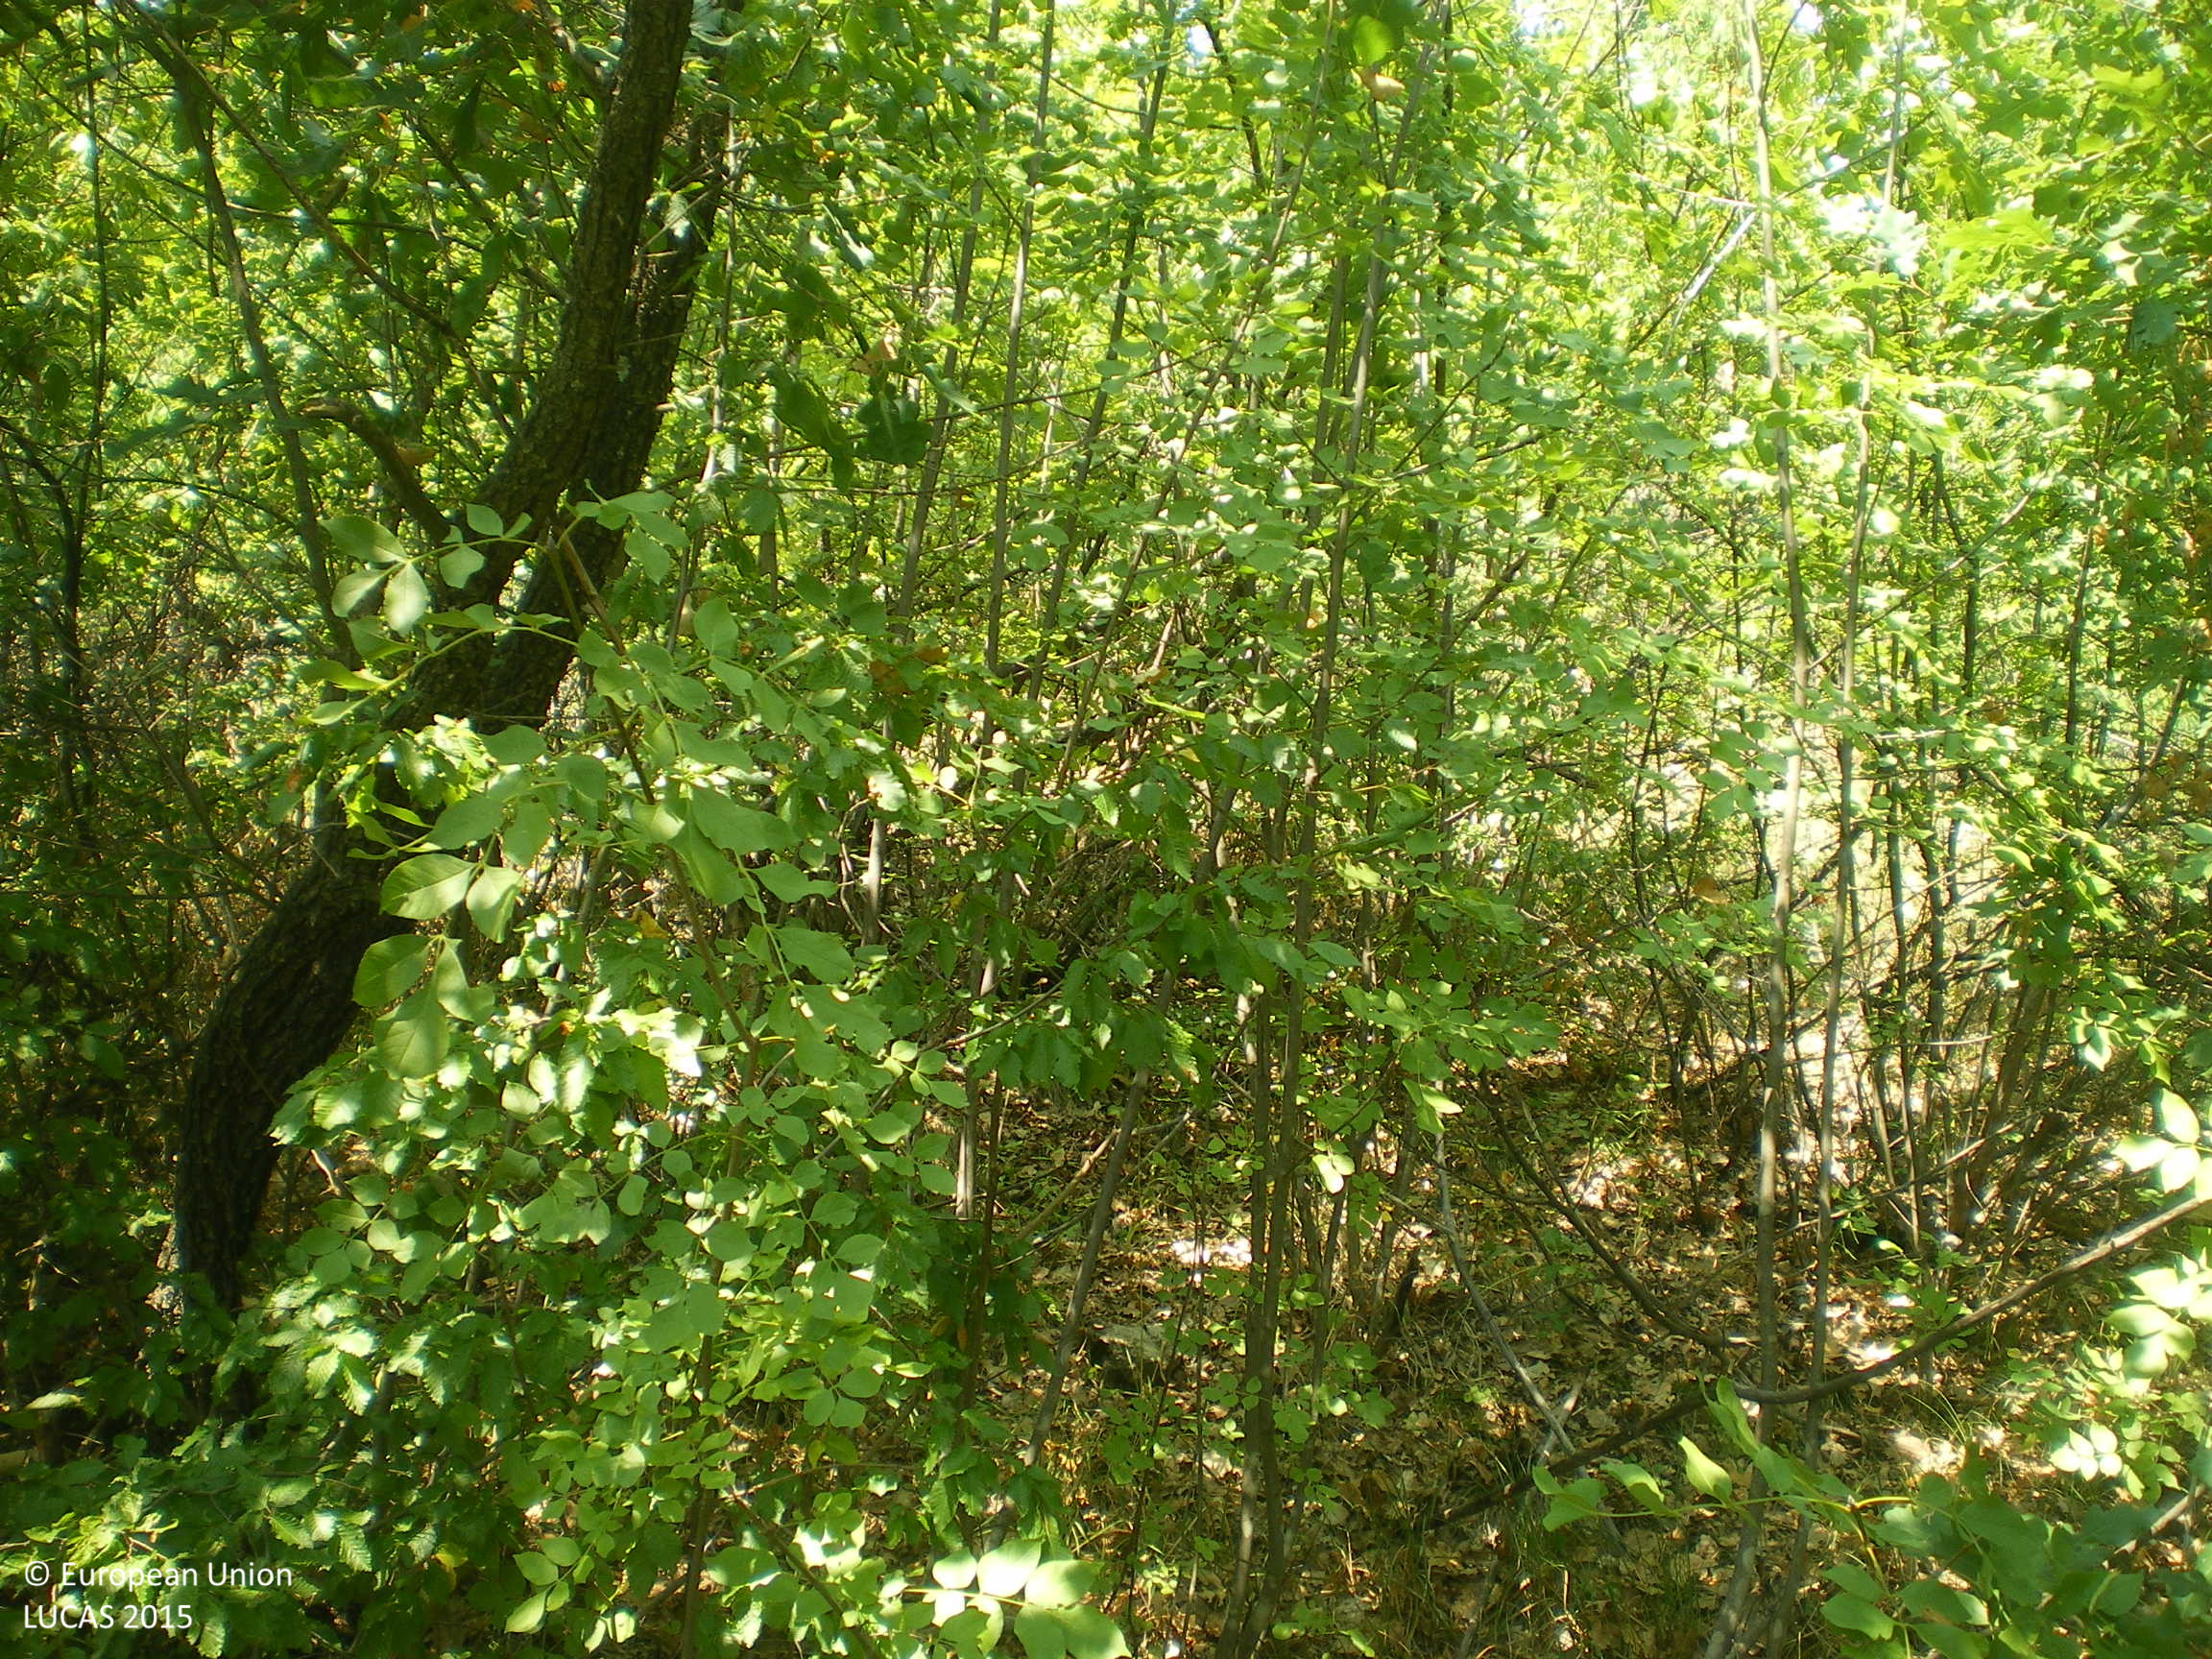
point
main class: Woodland
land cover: Broadleaved woodland
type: mesophytic deciduous forest
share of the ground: > 75 %
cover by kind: broadleaved forest trees 95 %, unconsolidated bare surface 5 %
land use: Forestry
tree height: > 5 m
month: August
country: BG
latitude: 42.3771
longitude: 25.4551
